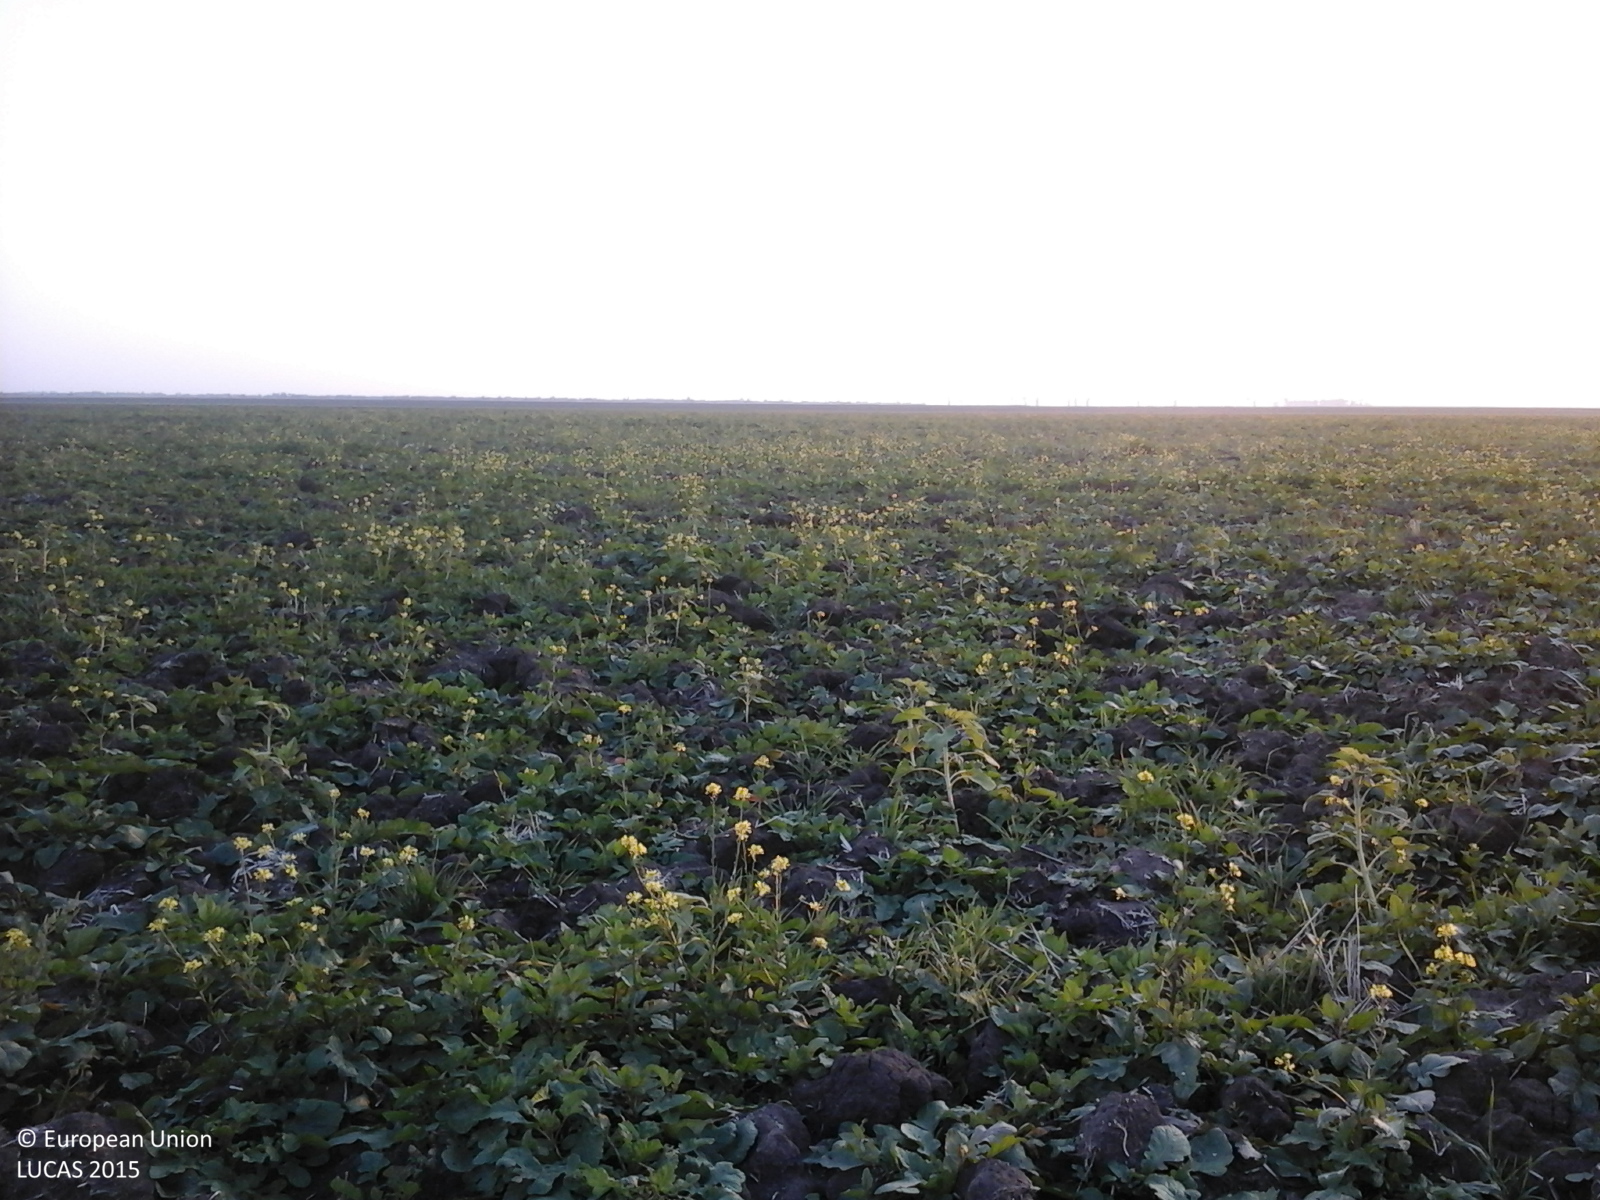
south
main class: Grassland
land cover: Spontaneously vegetated surfaces
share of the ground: > 75 %
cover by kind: herbaceous plants 100 %
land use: Fallow land
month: October
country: RO
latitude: 45.2461
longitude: 27.0445
